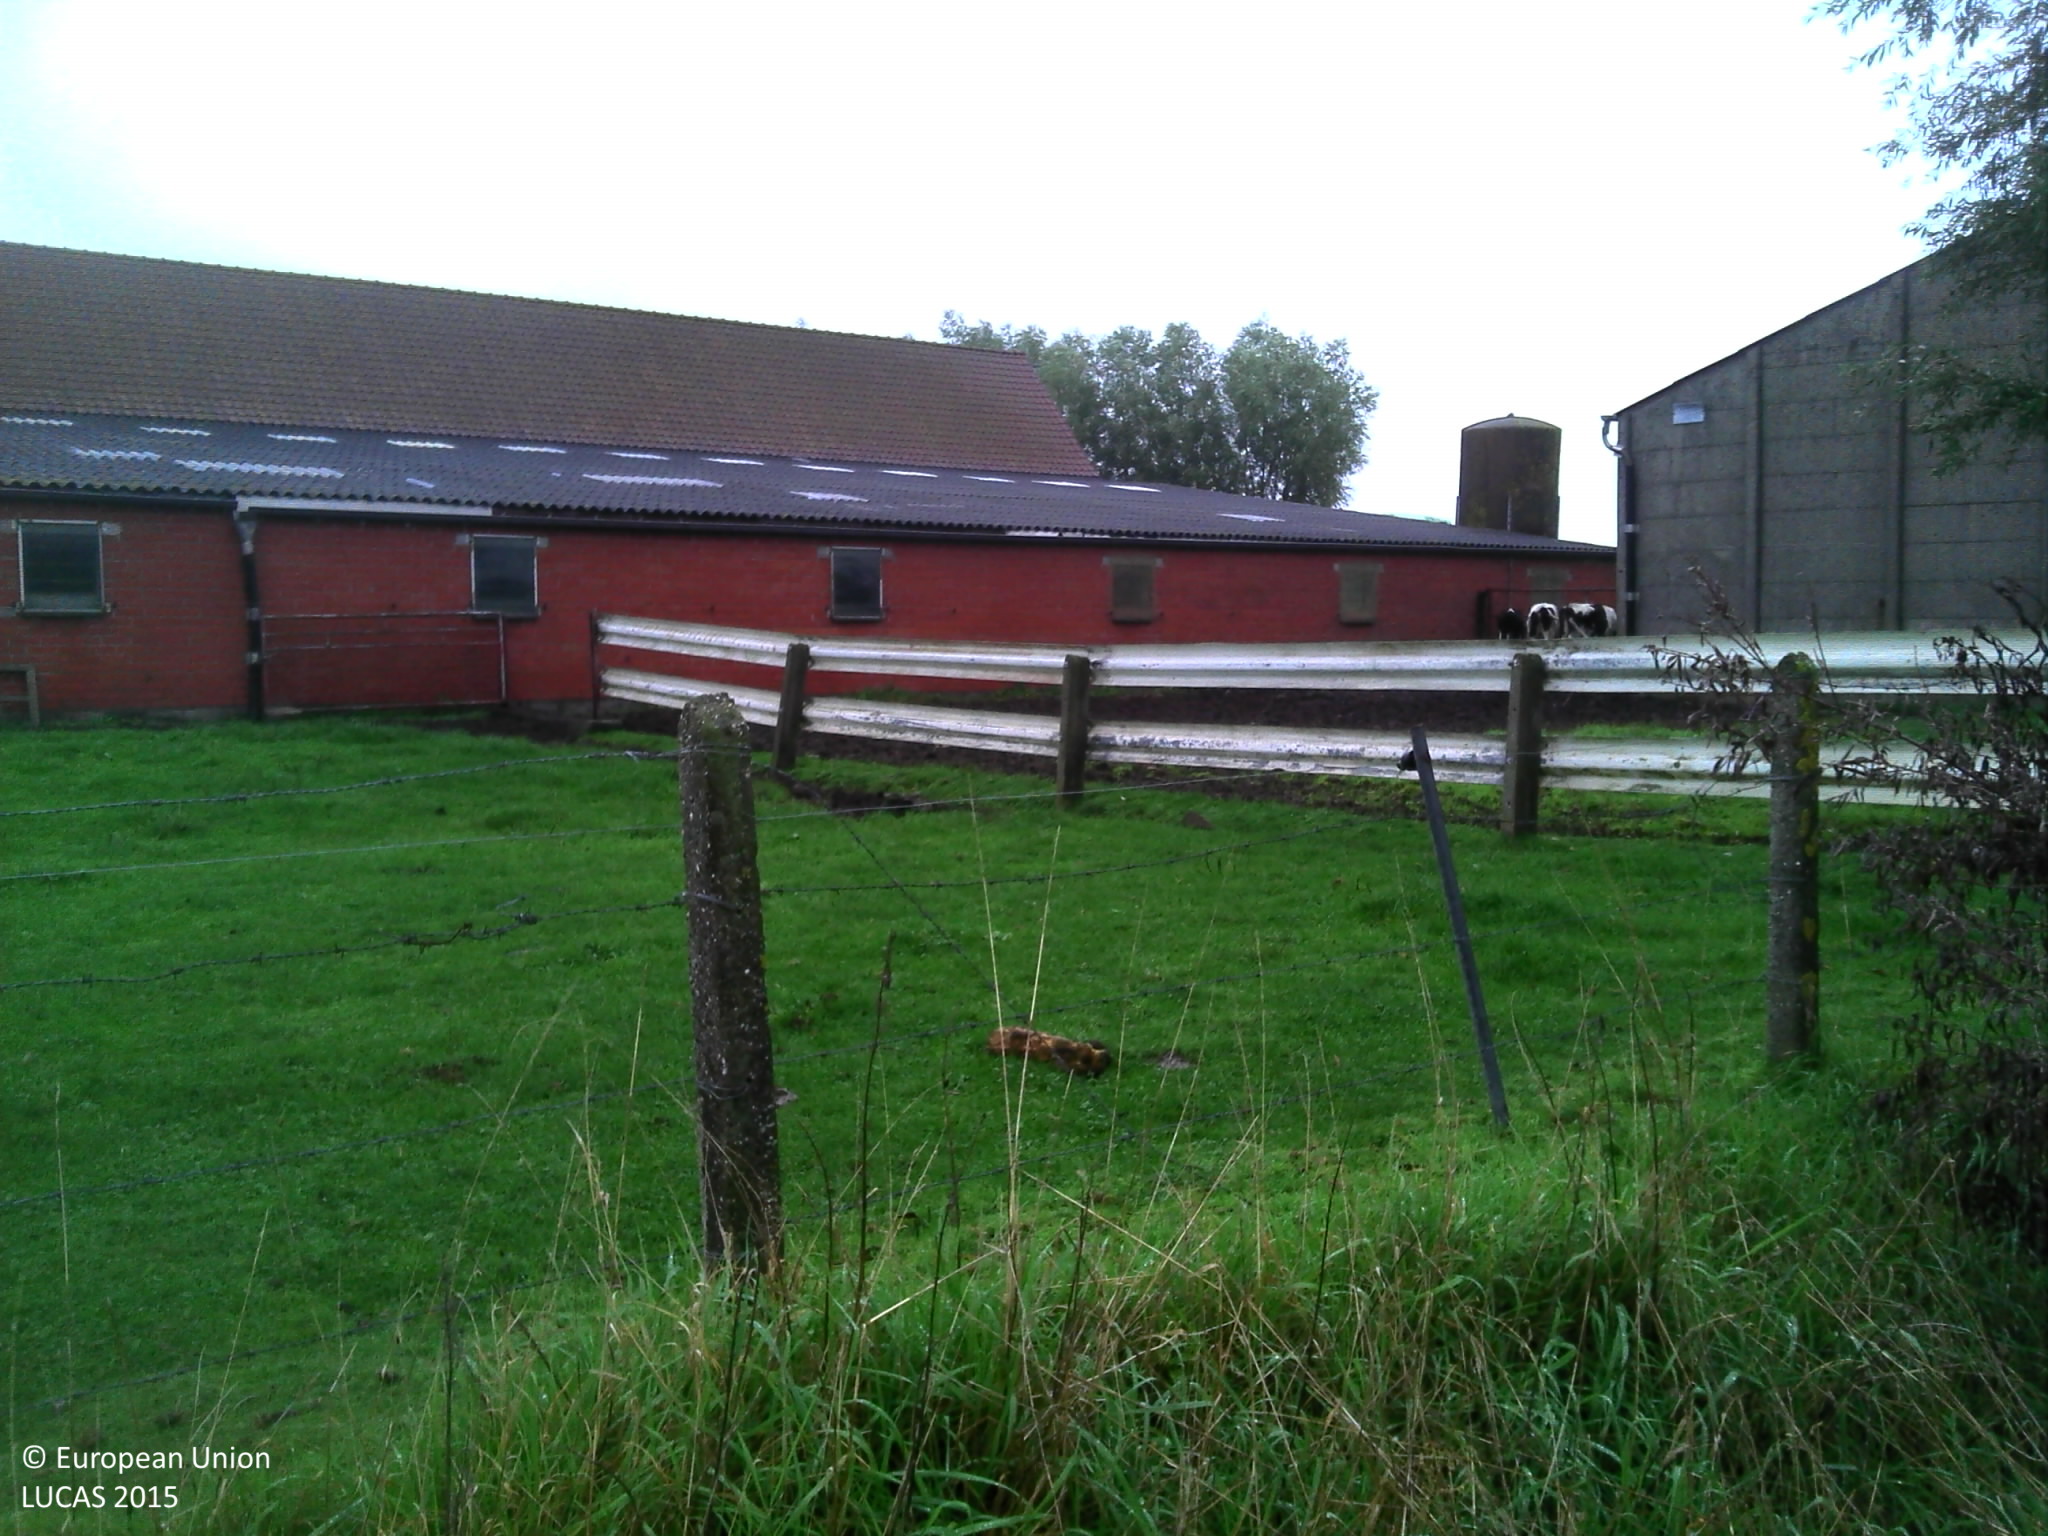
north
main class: Grassland
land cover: Grassland without tree/shrub cover
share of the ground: > 75 %
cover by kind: herbaceous plants 100 %
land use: Agriculture (excluding fallow land and kitchen gardens)
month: October
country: BE
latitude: 50.9905
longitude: 2.8801
